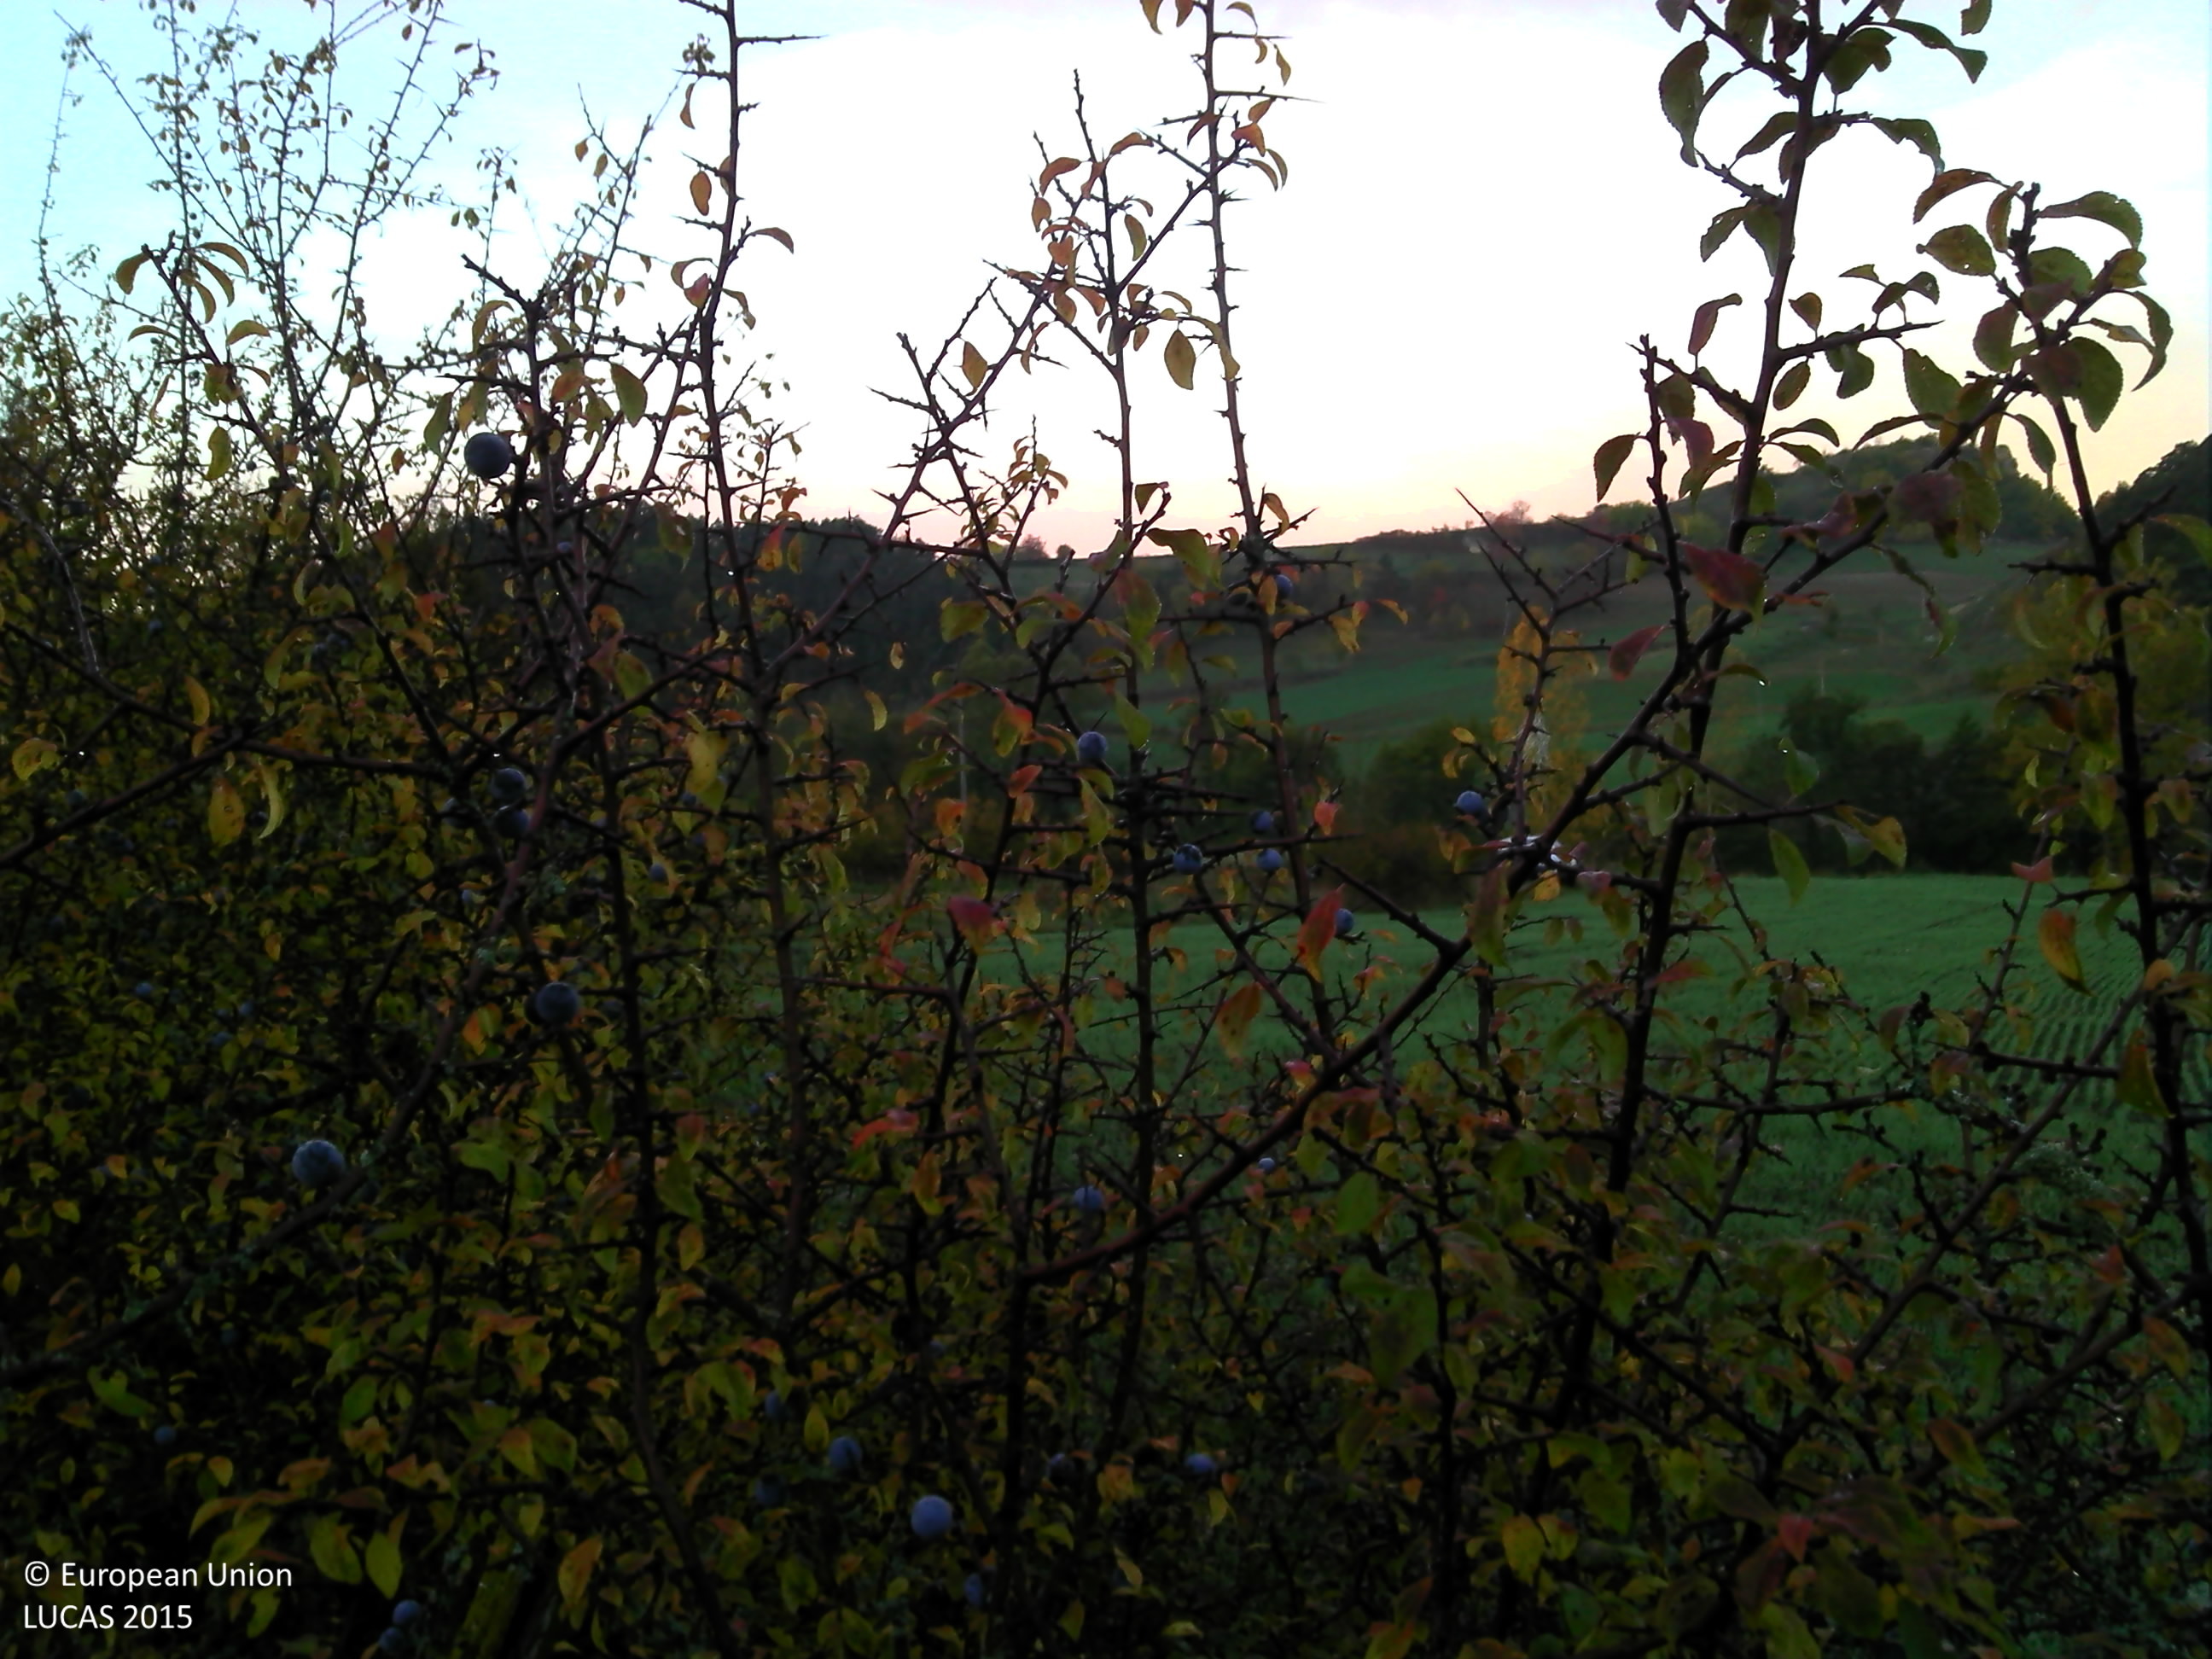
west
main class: Cropland
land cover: Common wheat
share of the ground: 25 - 50 %
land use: Agriculture (excluding fallow land and kitchen gardens)
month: October
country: FR
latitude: 45.0911
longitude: 3.8669
